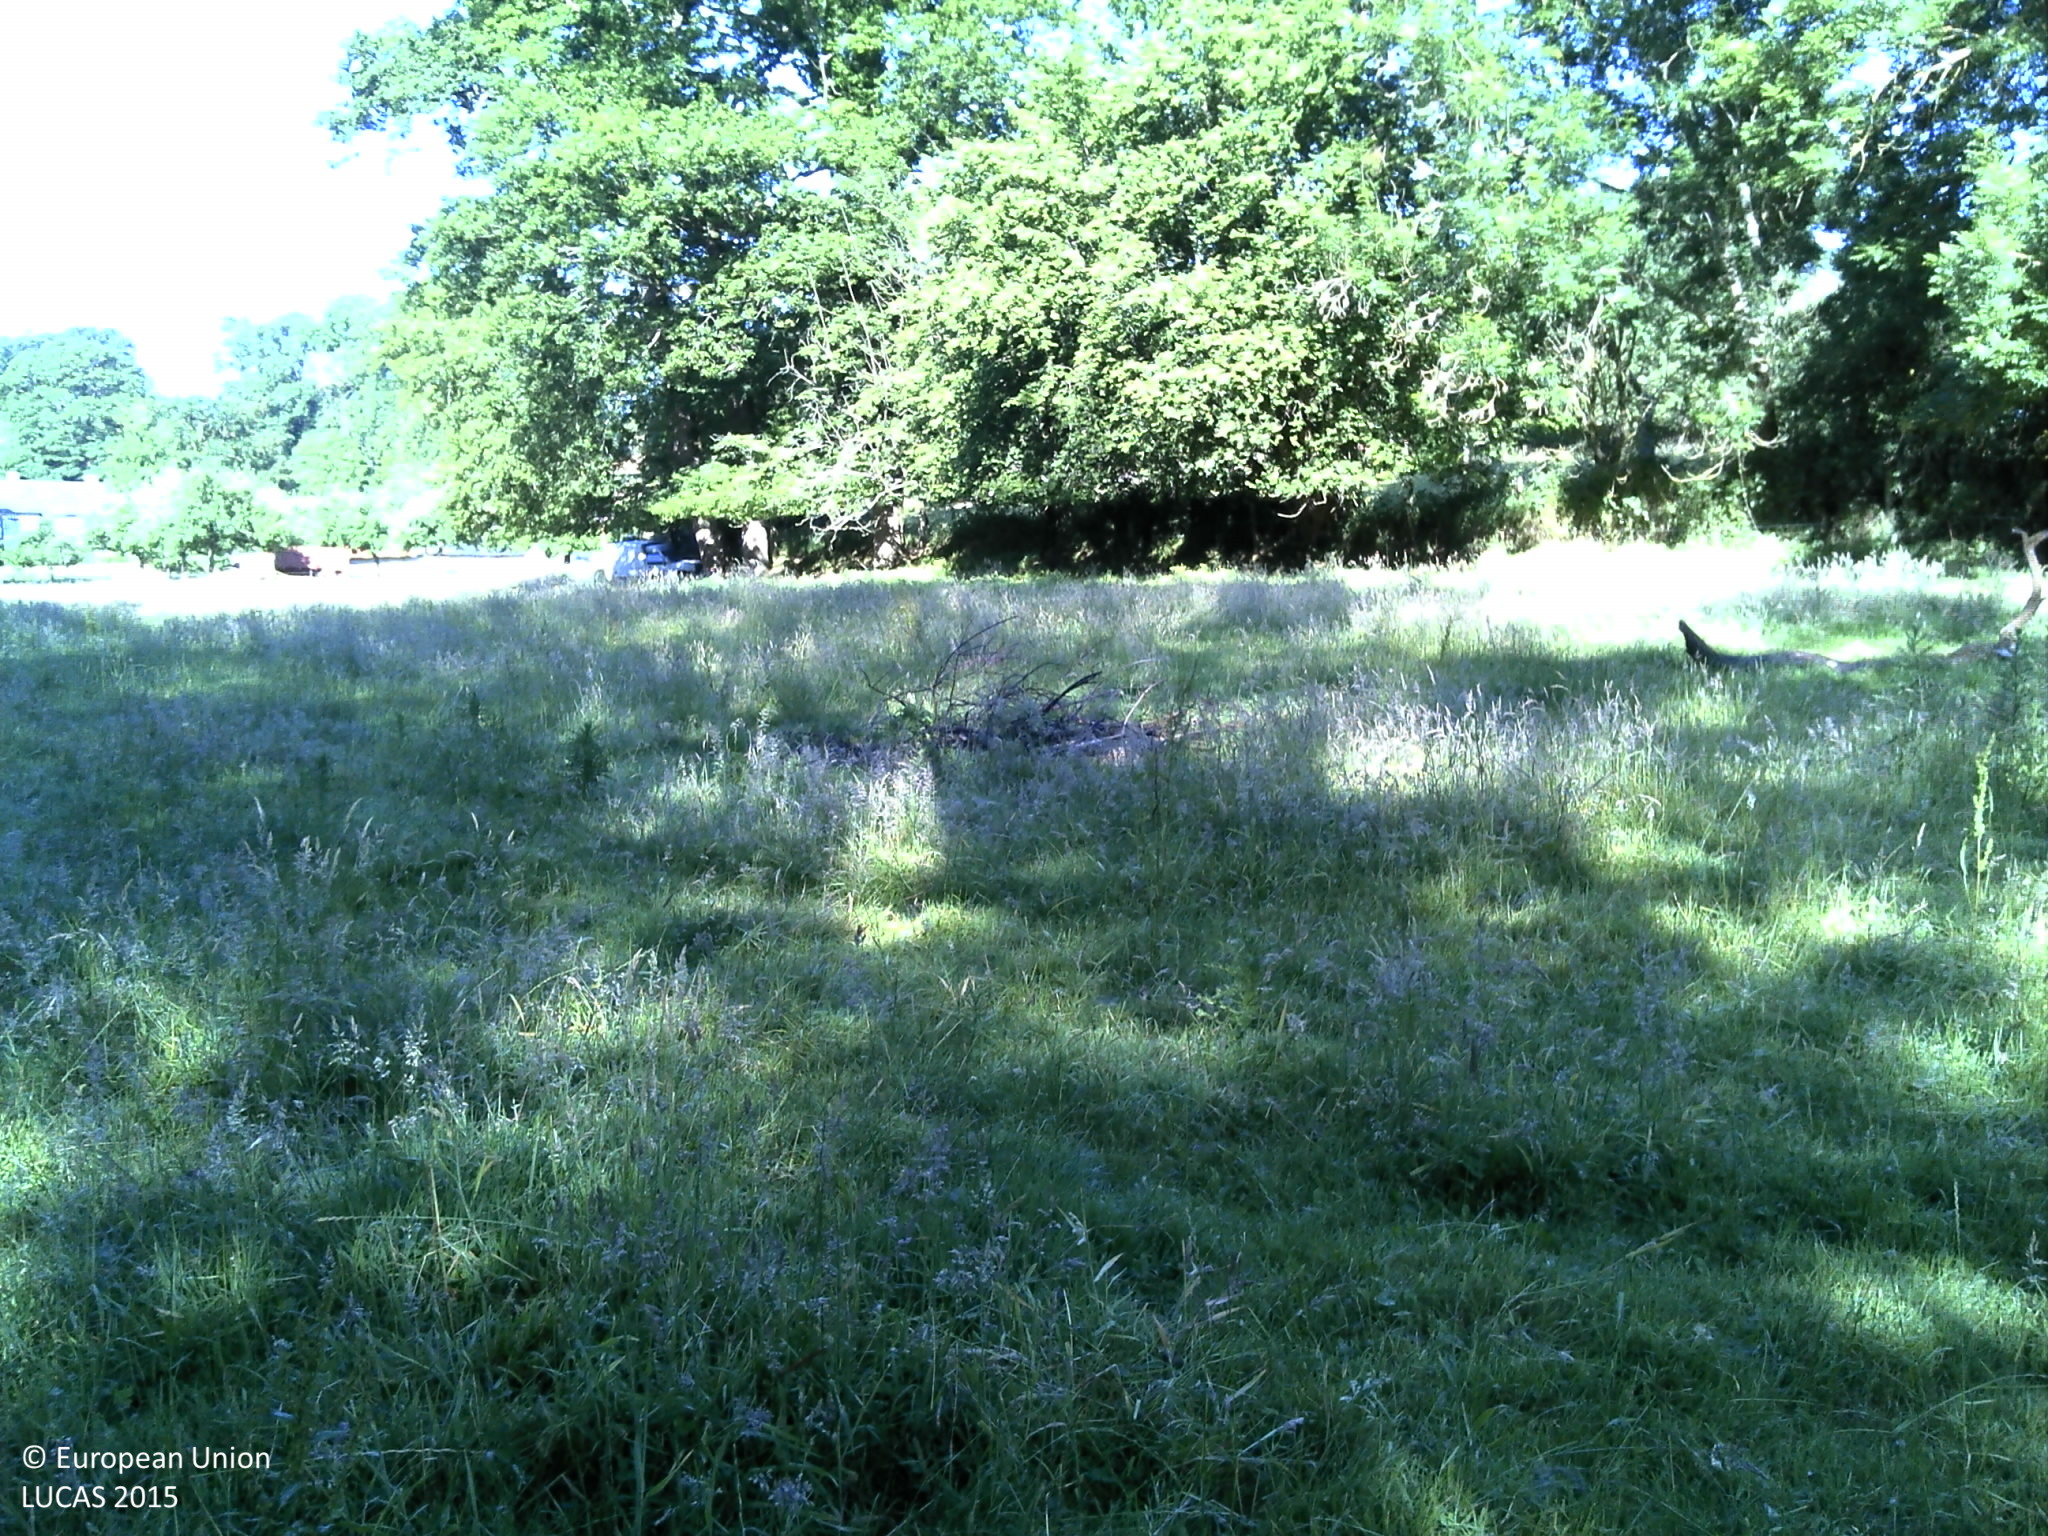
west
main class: Grassland
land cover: Grassland without tree/shrub cover
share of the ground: > 75 %
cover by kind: herbaceous plants 100 %
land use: Agriculture (excluding fallow land and kitchen gardens)
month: June
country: FR
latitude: 49.8085
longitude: 0.9866
